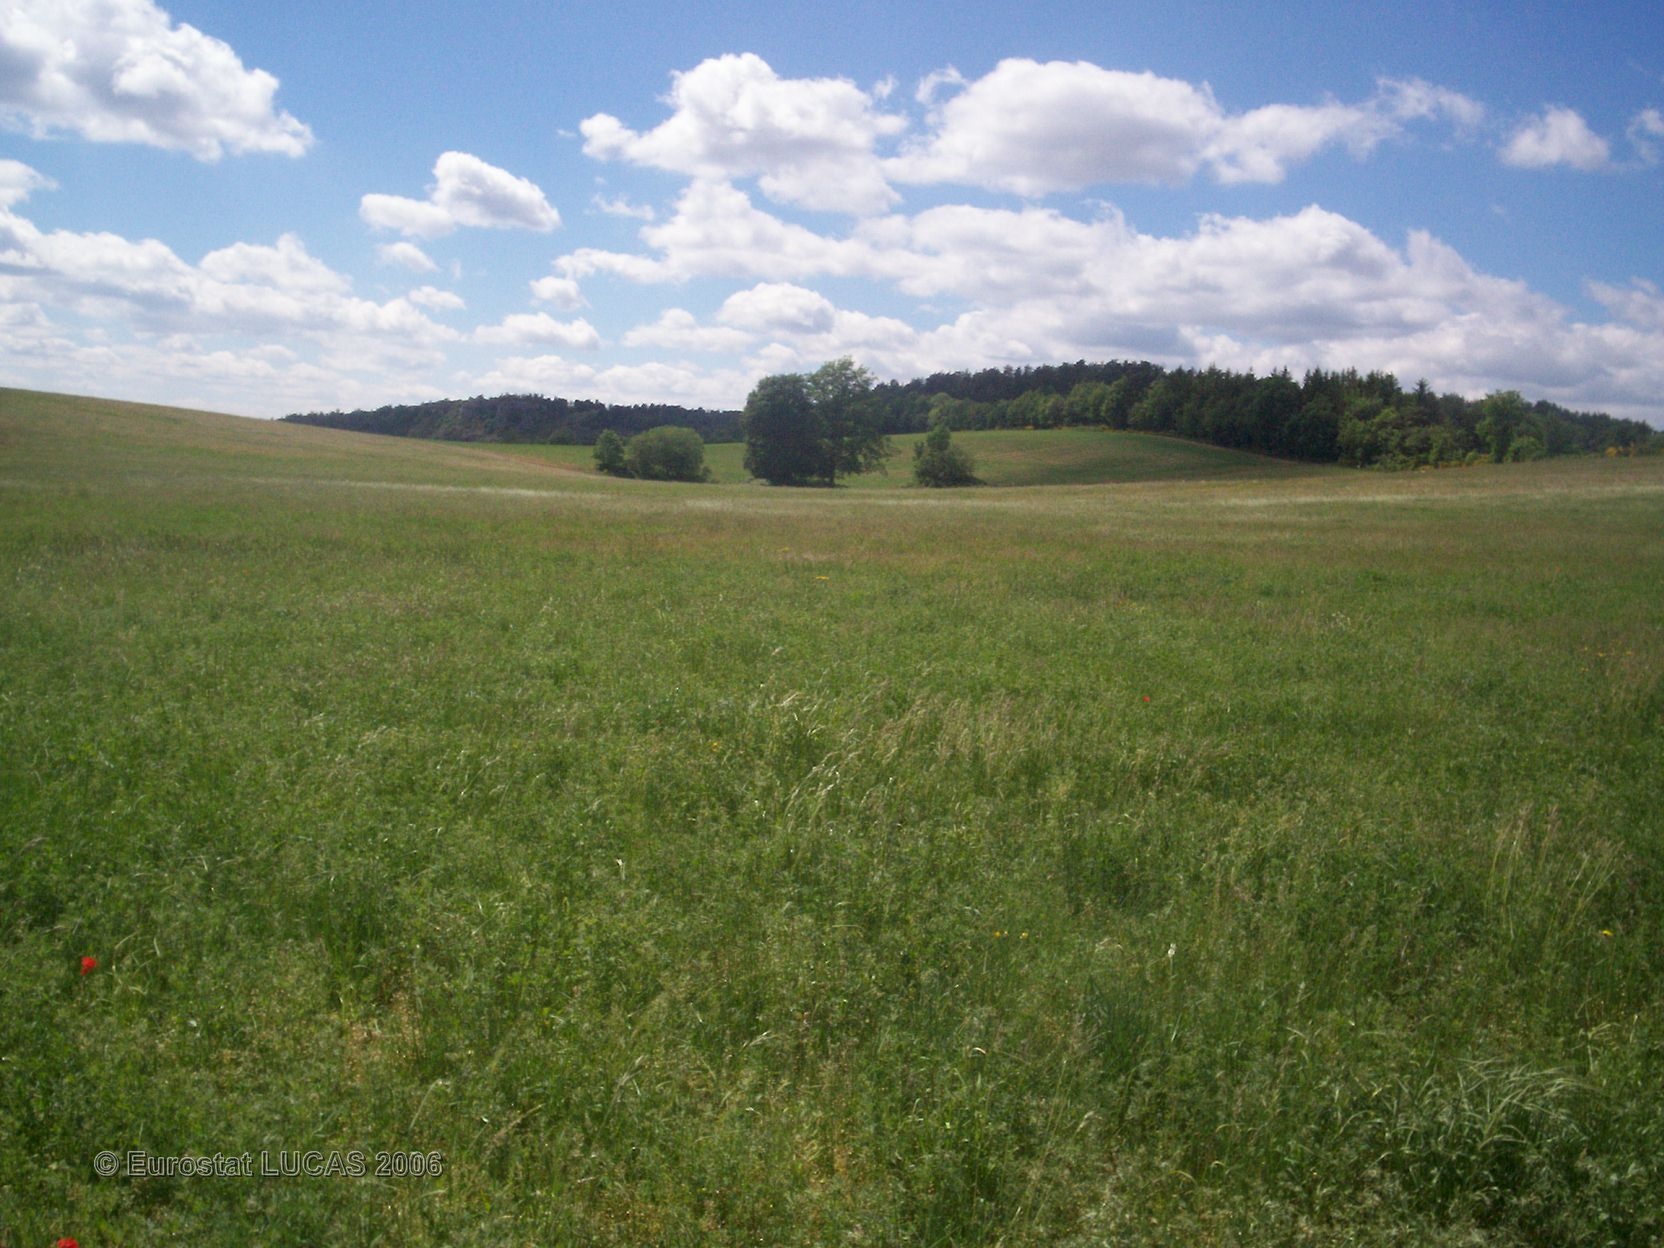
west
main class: Grassland
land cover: Grassland without tree/shrub cover
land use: Agriculture (excluding fallow land and kitchen gardens)
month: June
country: FR
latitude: 44.4975
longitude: 3.3268
